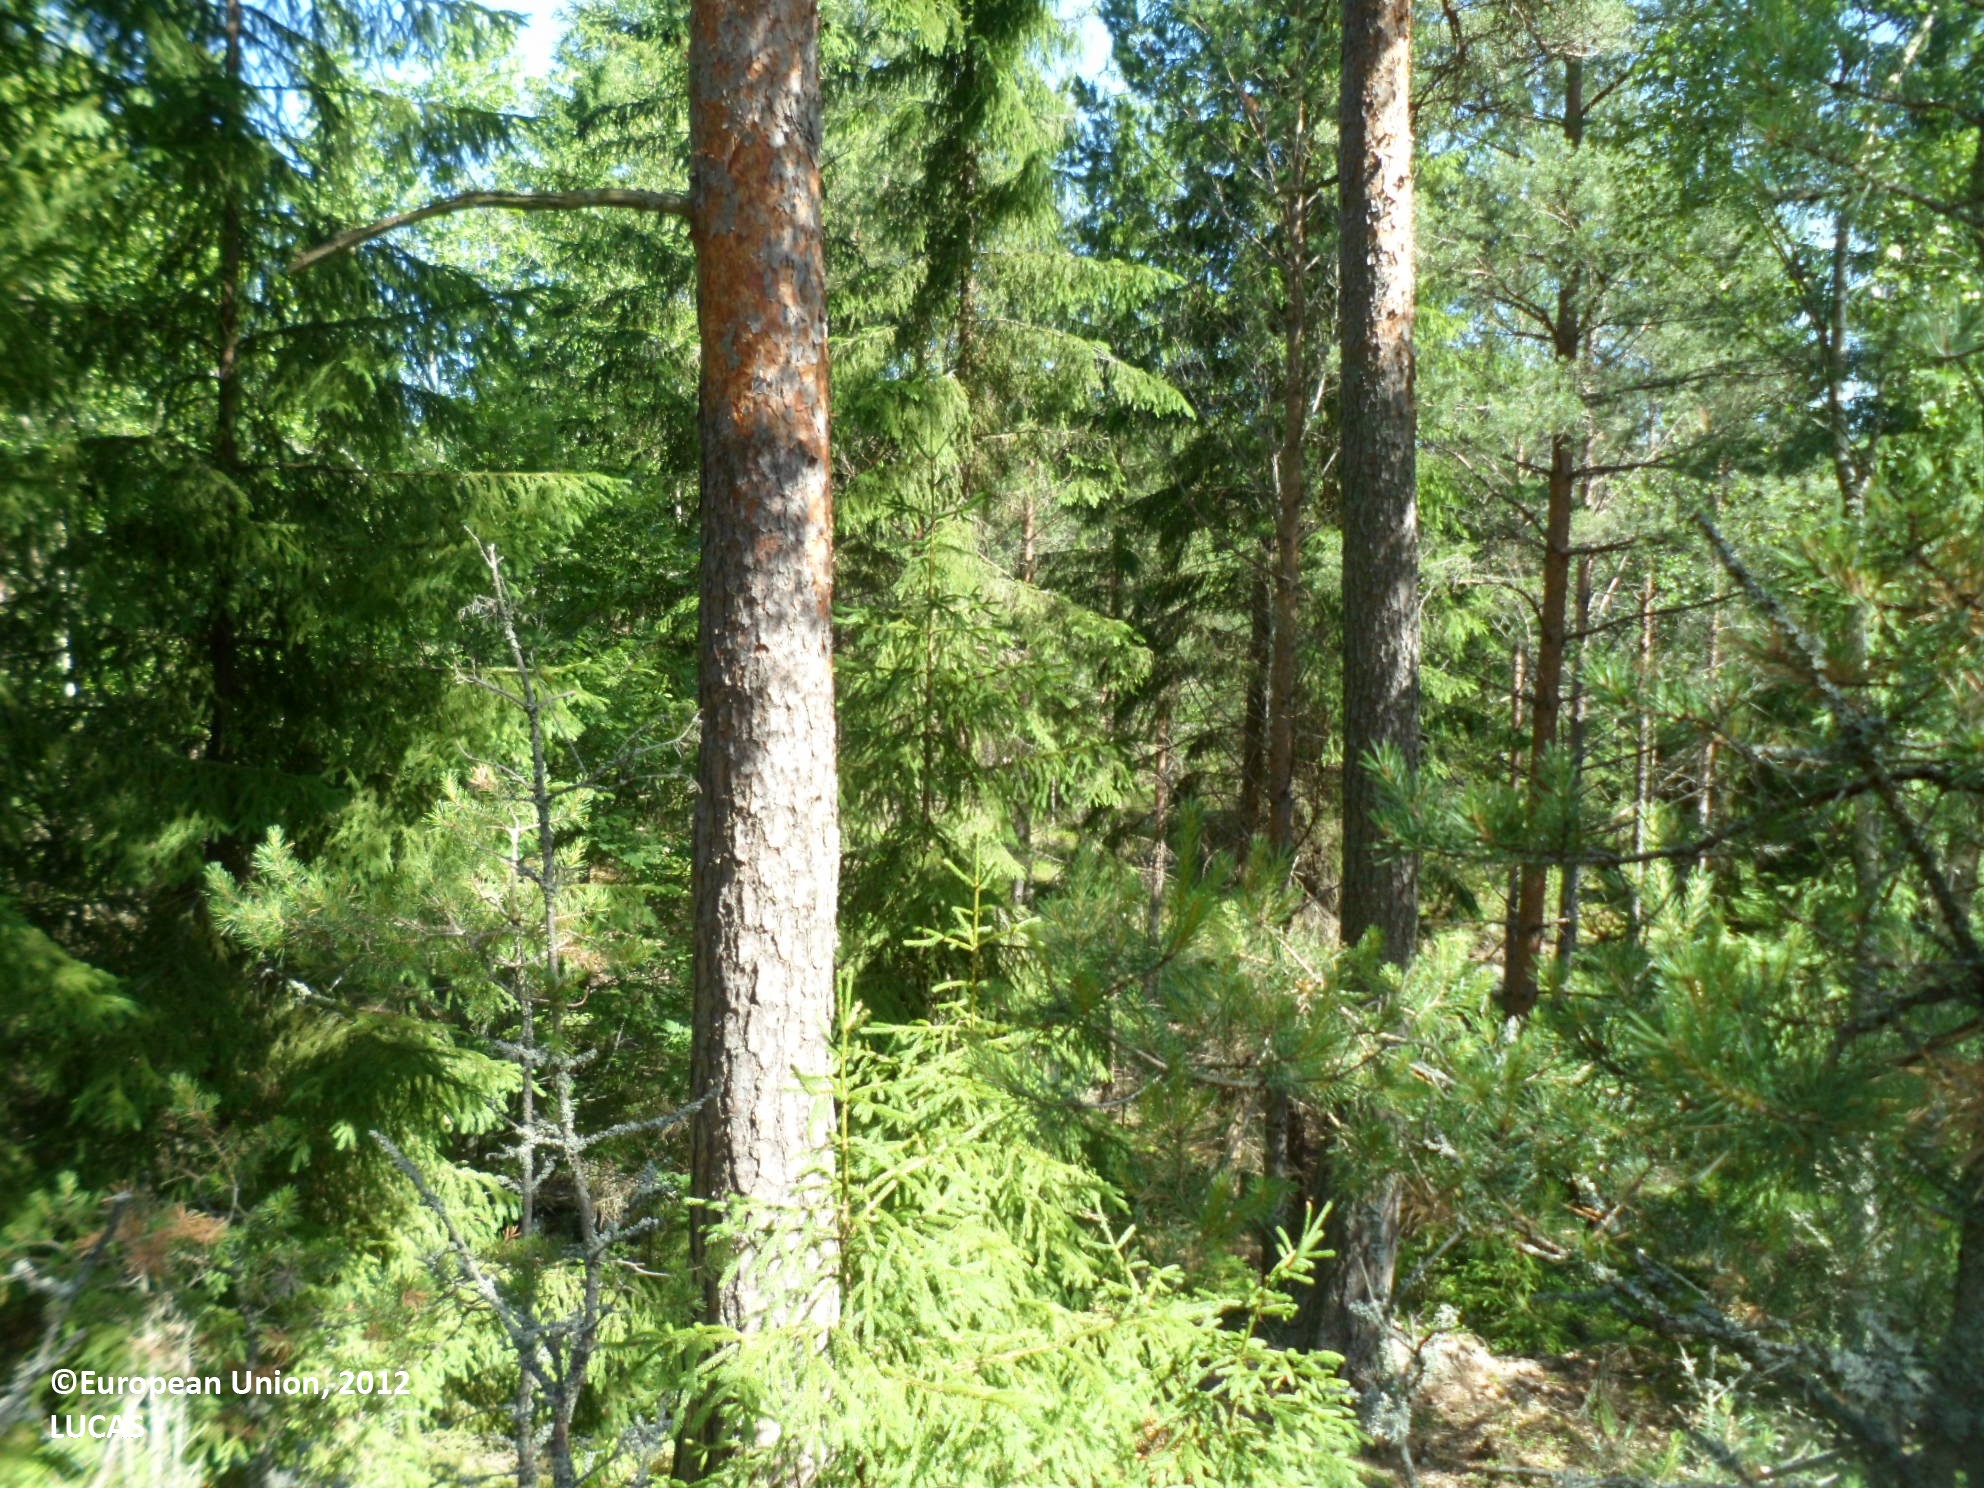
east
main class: Woodland
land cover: Pine dominated coniferous woodland
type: boreal forest
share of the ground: 50 - 75 %
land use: Forestry
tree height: > 5 m
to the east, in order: Pine dominated coniferous woodland; Spruce dominated coniferous woodland; Fences; Spruce dominated coniferous woodland; Tracks; Spruce dominated coniferous woodland; Tracks; Spruce dominated coniferous woodland; Ditches and canals; Spruce dominated coniferous woodland; Tracks; Spruce dominated coniferous woodland; Ditches and canals; Spruce dominated coniferous woodland; Fences; Spruce dominated coniferous woodland; Tracks; Spruce dominated coniferous woodland
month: July
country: SE
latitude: 59.3781
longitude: 18.5373
